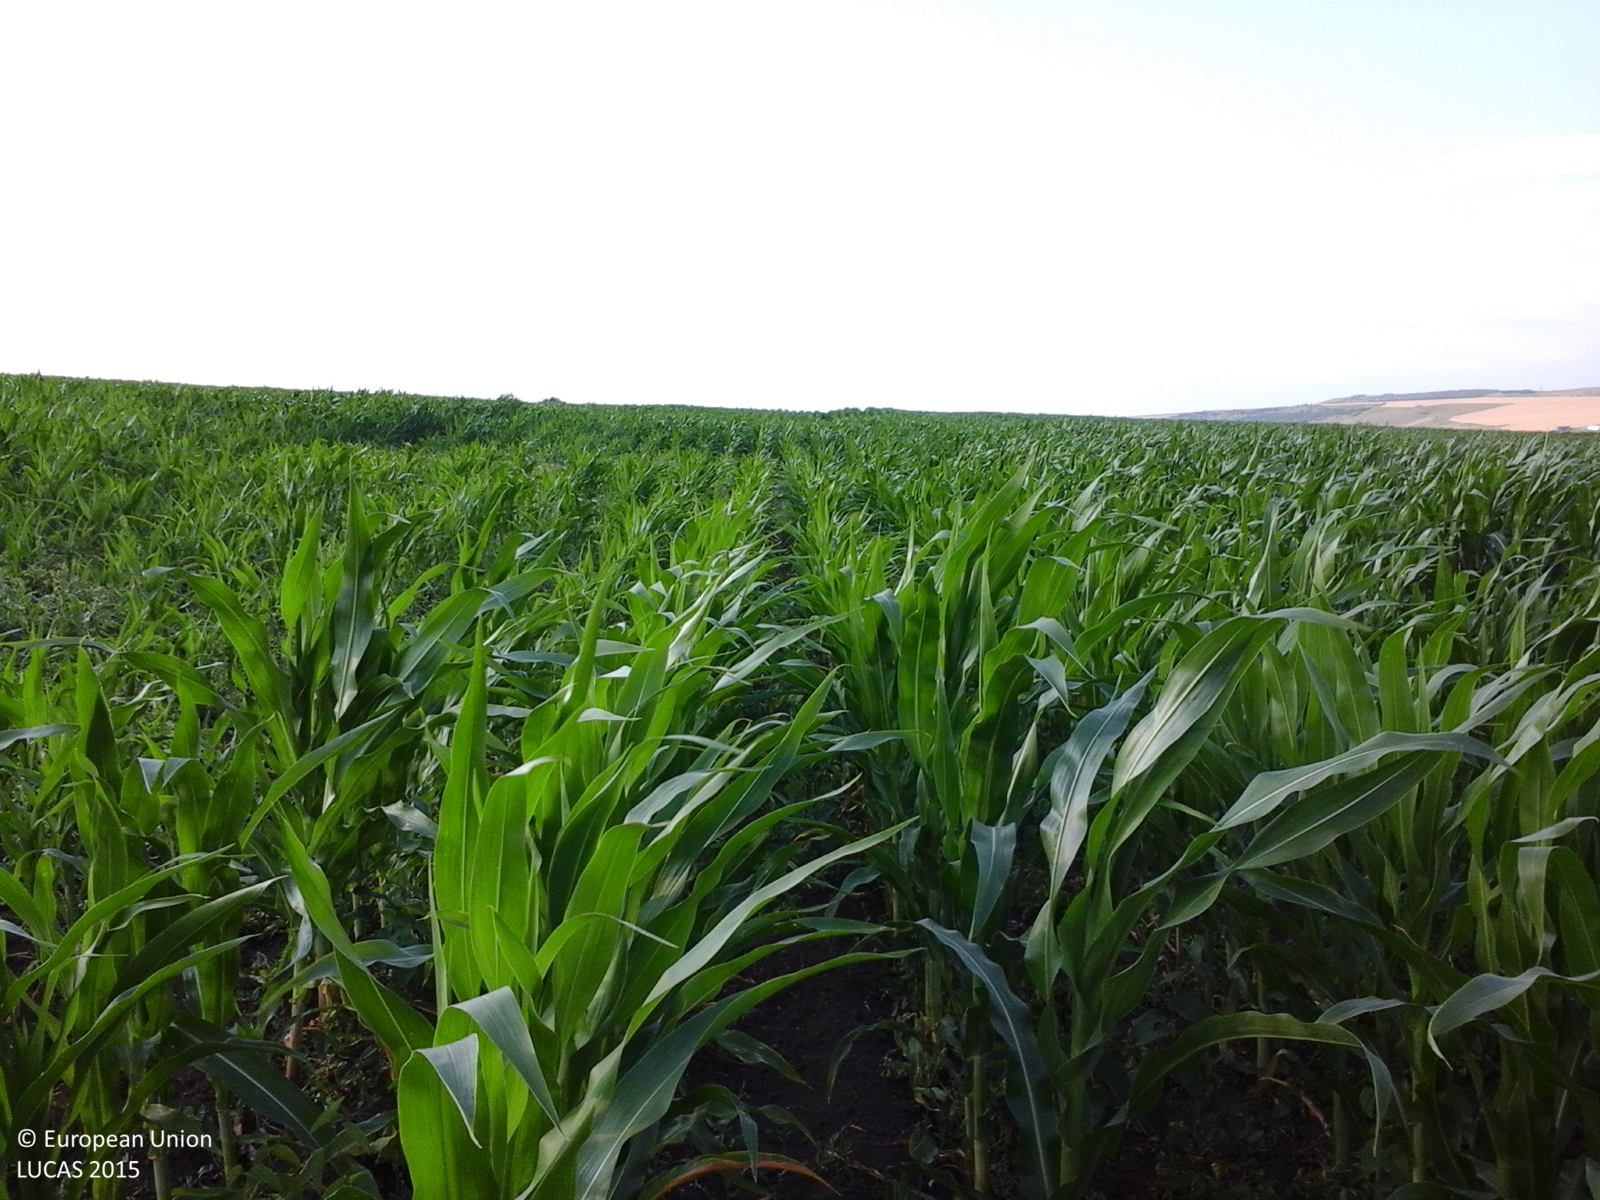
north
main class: Cropland
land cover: Maize
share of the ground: > 75 %
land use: Agriculture (excluding fallow land and kitchen gardens)
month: June
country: RO
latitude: 47.1692
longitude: 27.4360
